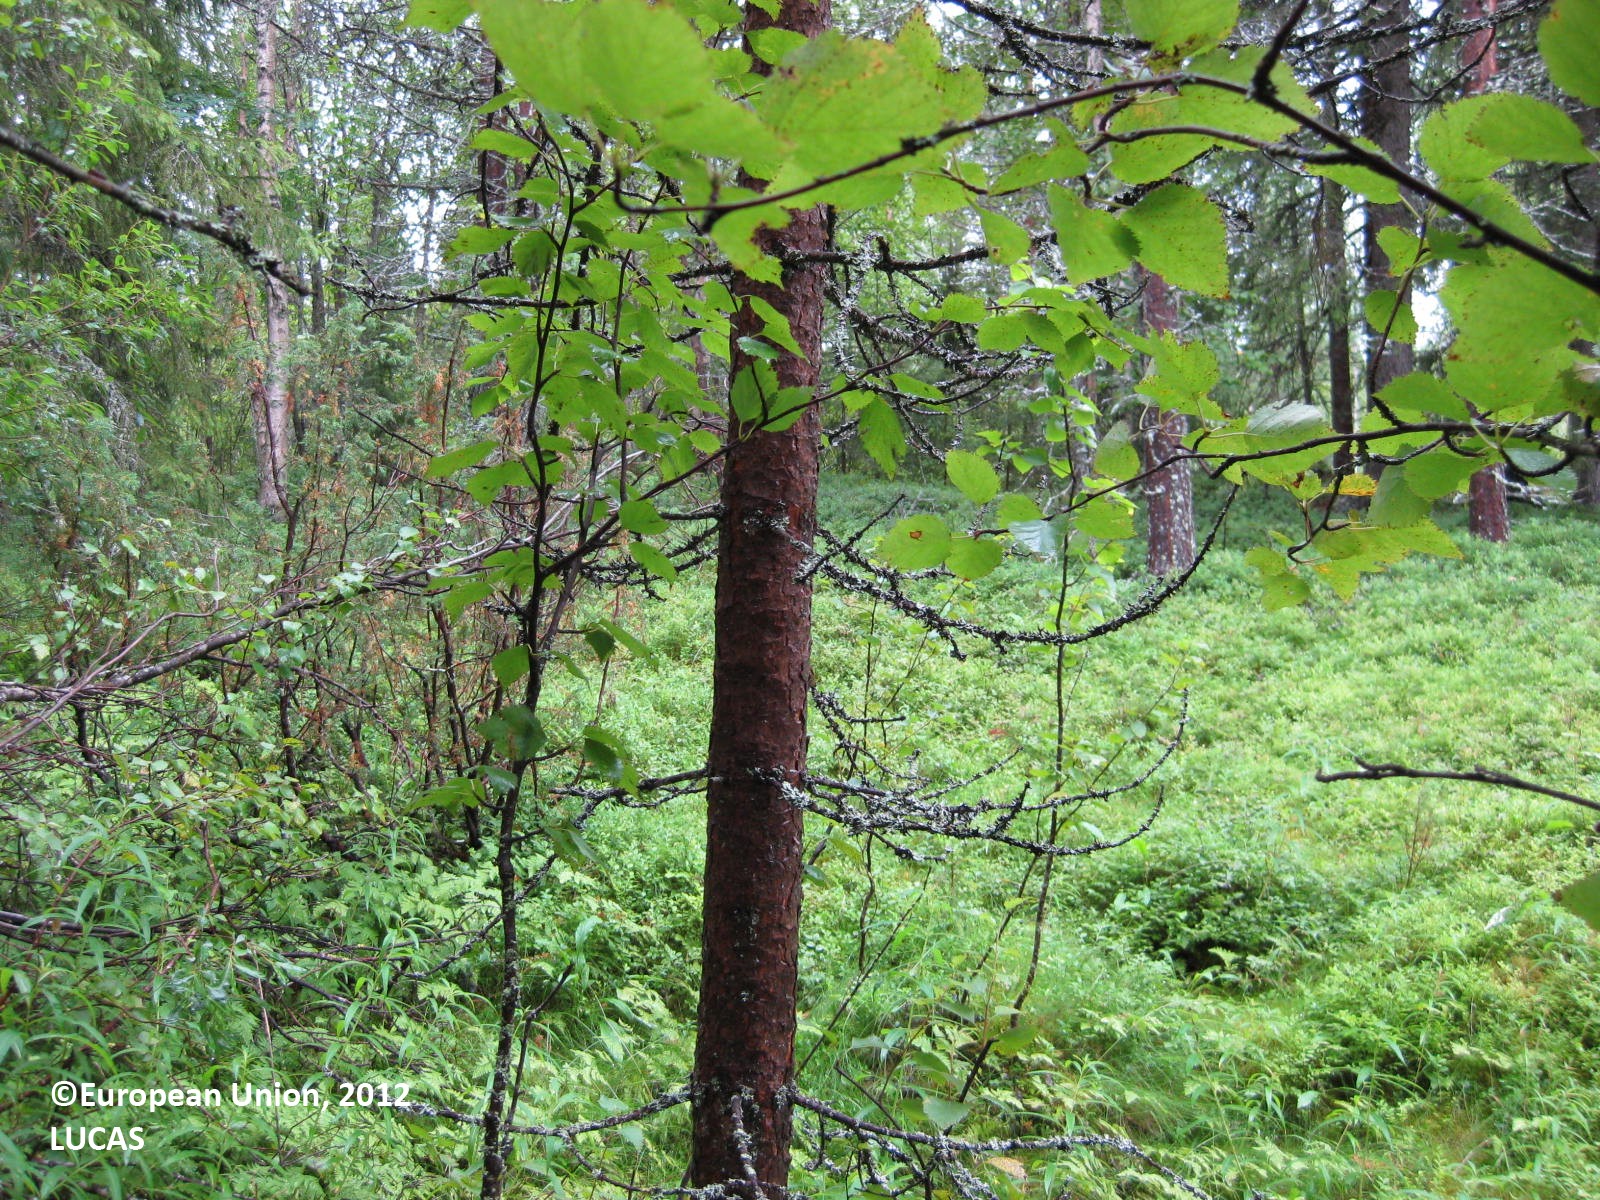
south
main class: Woodland
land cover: Other mixed woodland
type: boreal forest
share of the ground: 50 - 75 %
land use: Forestry
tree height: > 5 m
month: August
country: FI
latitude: 65.8592
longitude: 28.1341
